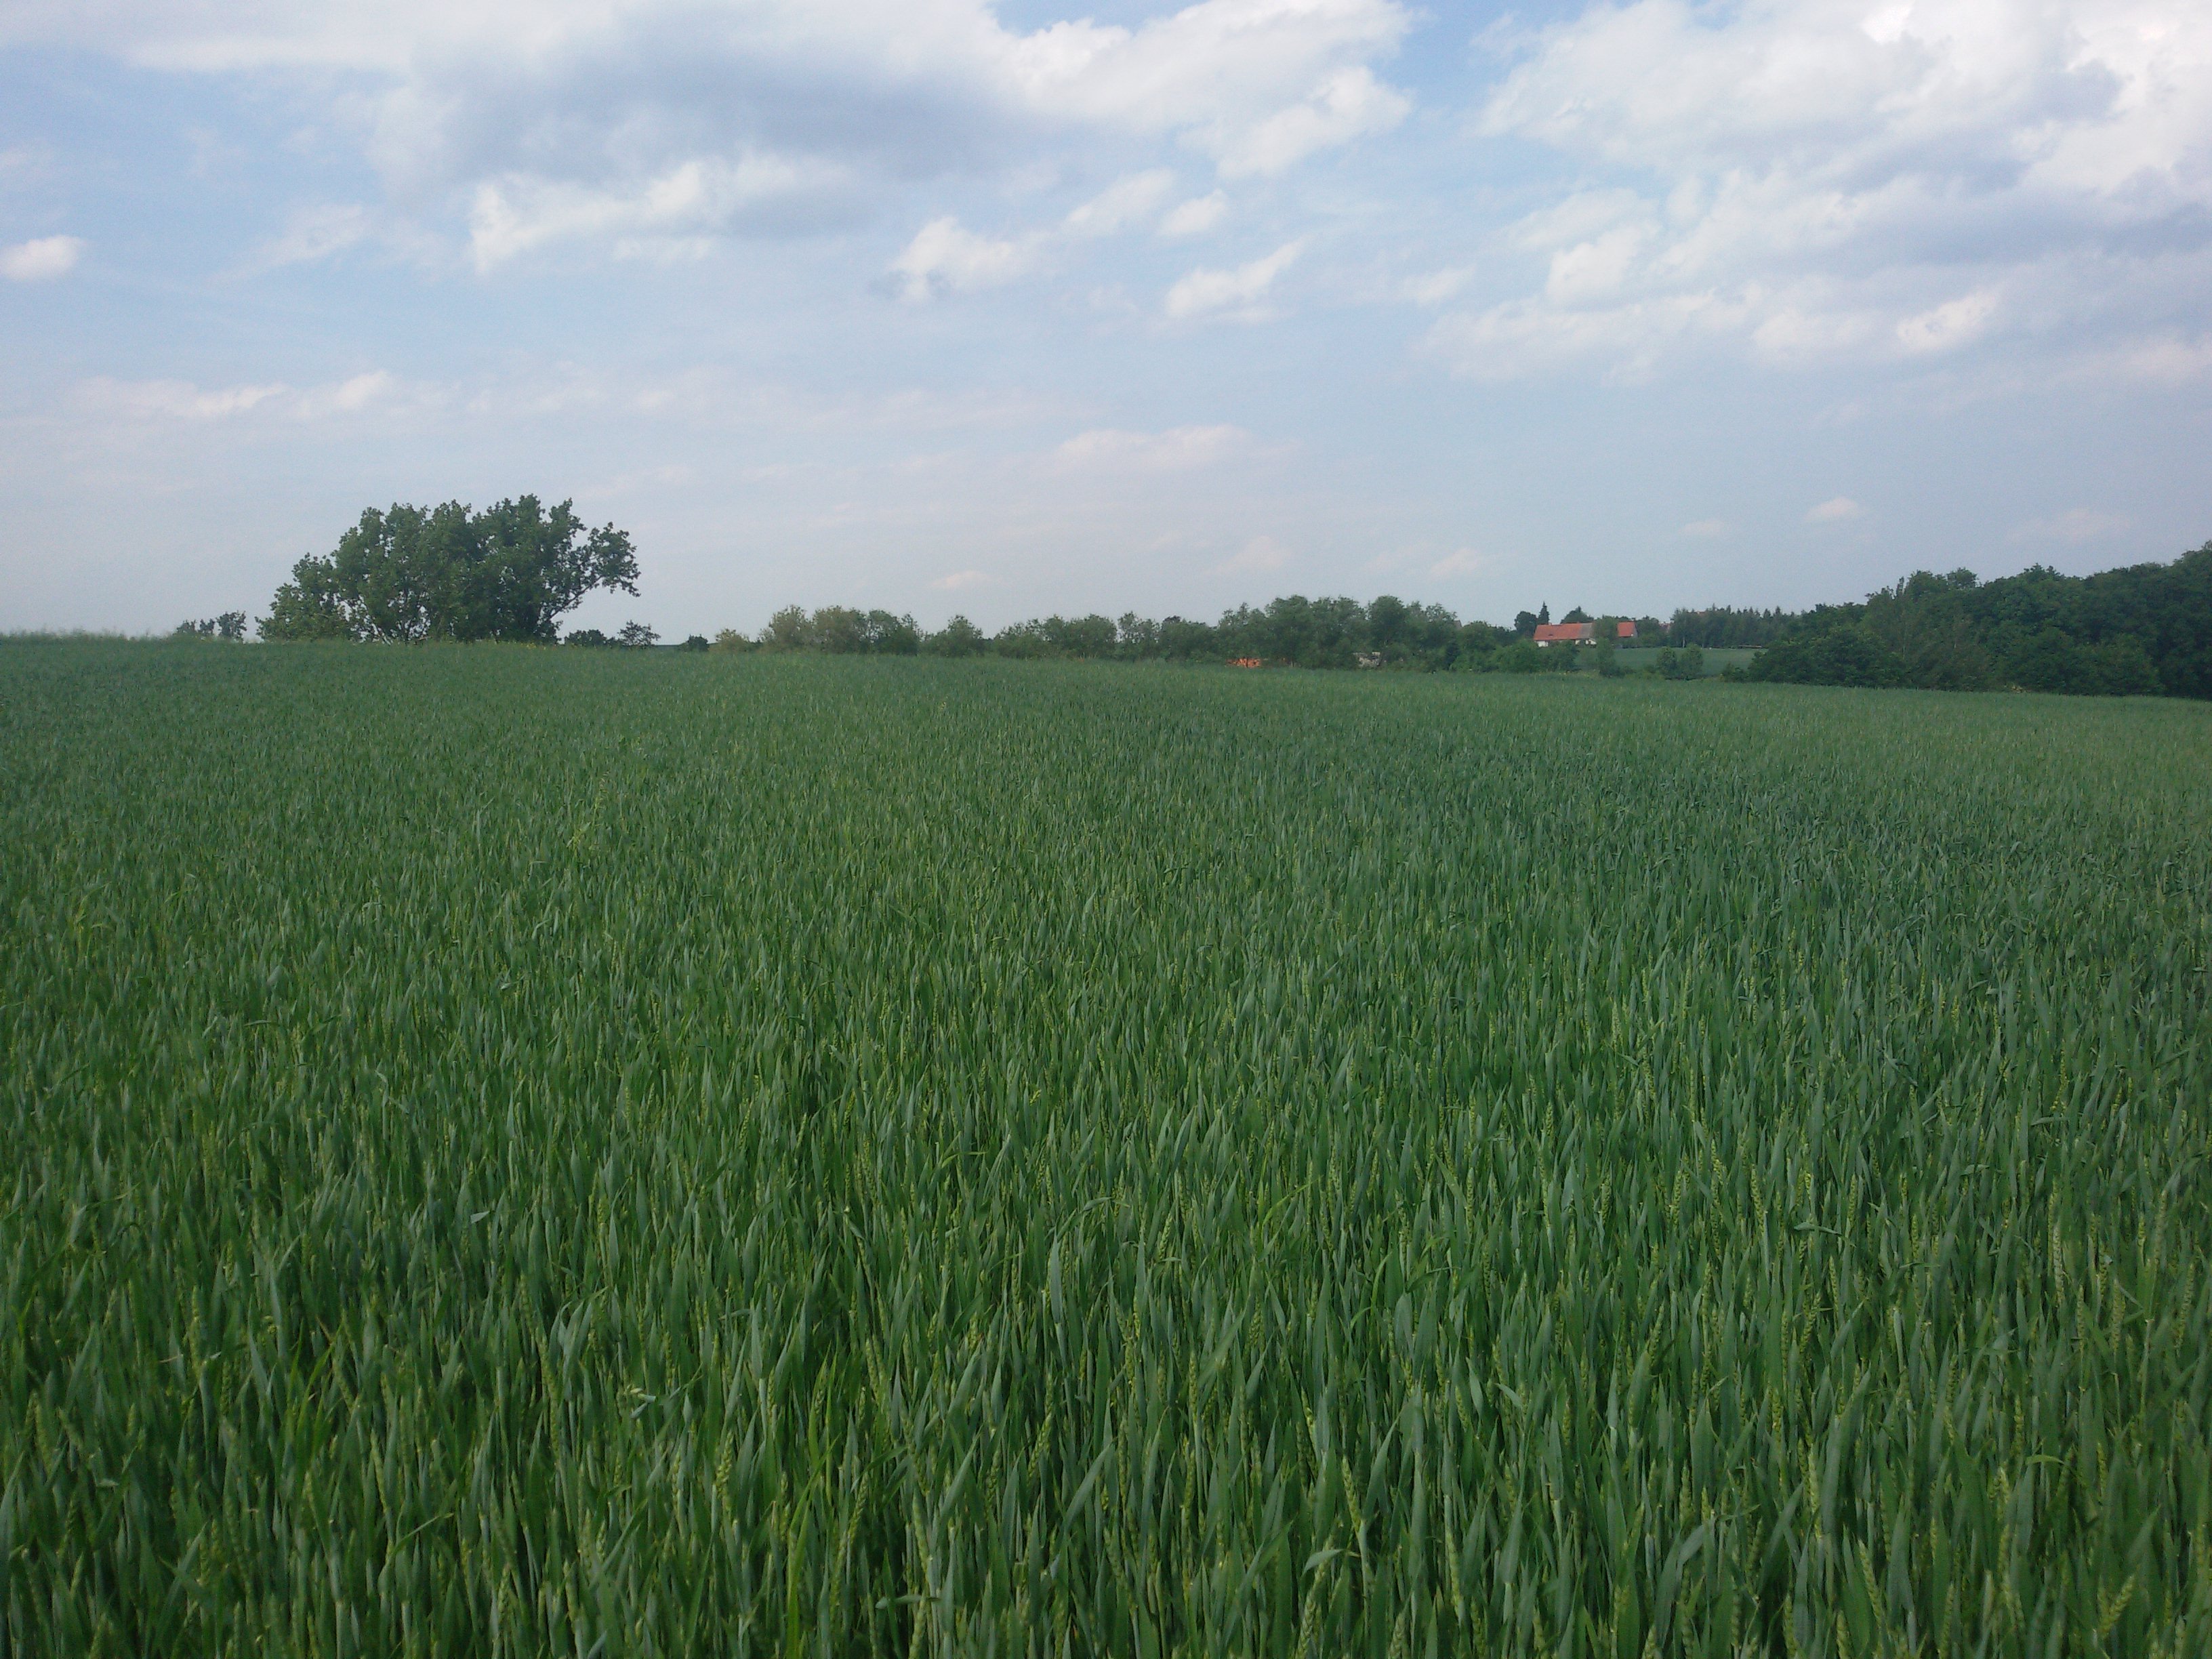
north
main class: Cropland
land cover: Common wheat
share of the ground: > 75 %
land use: Agriculture (excluding fallow land and kitchen gardens)
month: May
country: PL
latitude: 50.5347
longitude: 17.1923
